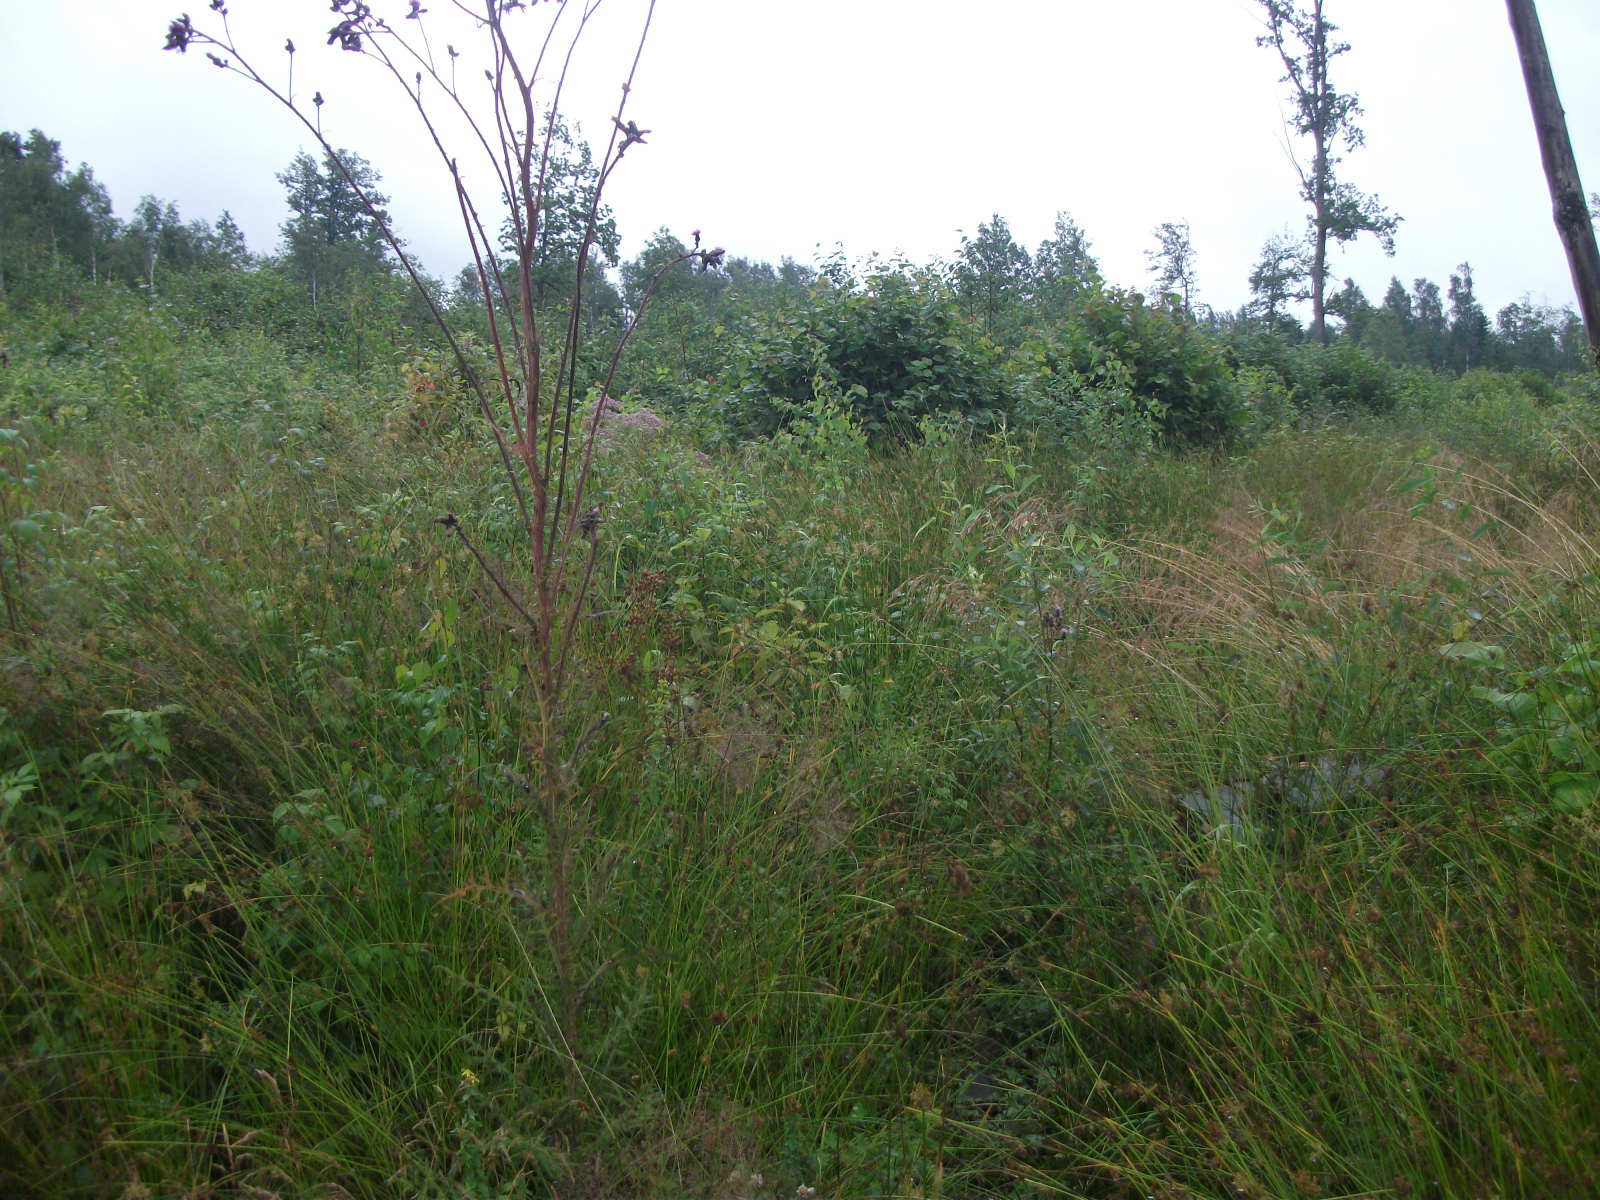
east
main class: Shrubland
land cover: Shrubland with sparse tree cover
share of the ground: > 75 %
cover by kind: shrubs 75 %, herbaceous plants 15 %, broadleaved forest trees 5 %, lichens and mosses 5 %
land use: Forestry
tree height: < 5 m
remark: Clear cut
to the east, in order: Shrubland with sparse tree cover; Broadleaved woodland; Spruce dominated mixed woodland; Broadleaved woodland
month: July
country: LV
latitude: 56.8157
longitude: 25.8040
